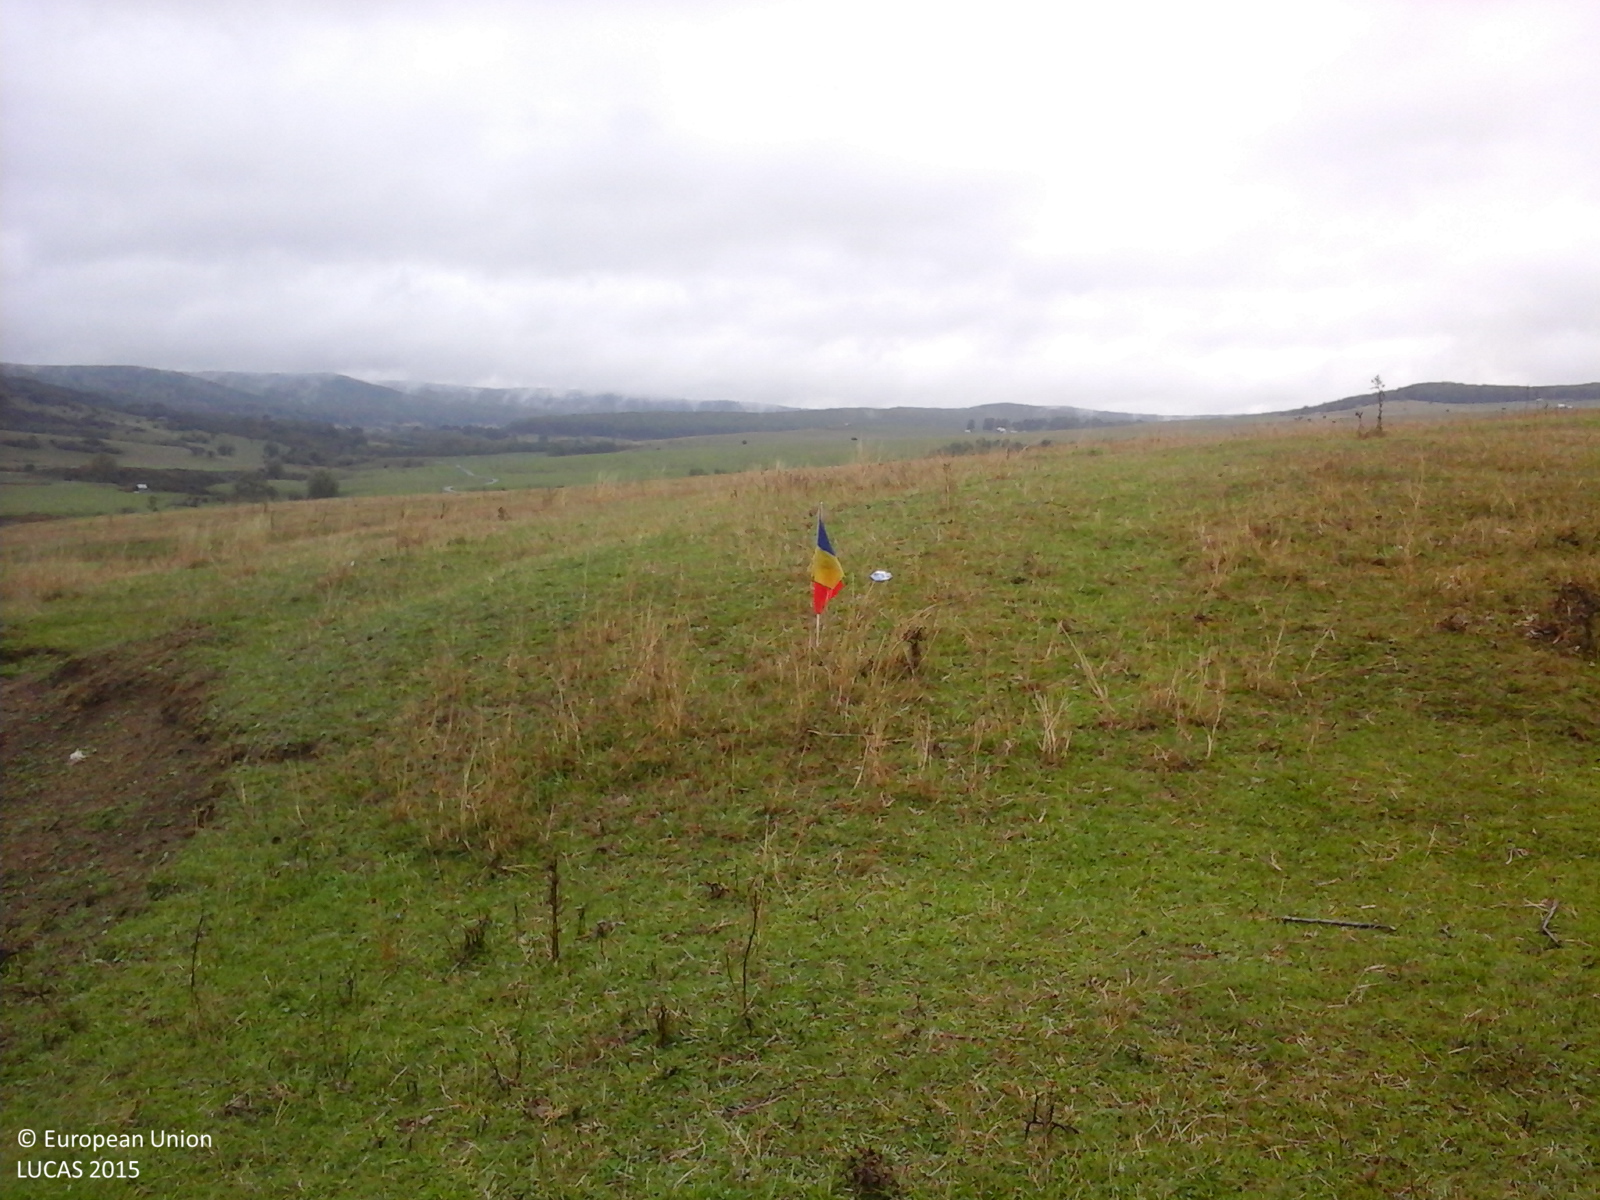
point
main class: Grassland
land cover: Grassland without tree/shrub cover
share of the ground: > 75 %
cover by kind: herbaceous plants 100 %
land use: Agriculture (excluding fallow land and kitchen gardens)
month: October
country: RO
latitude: 45.8781
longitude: 24.0267
